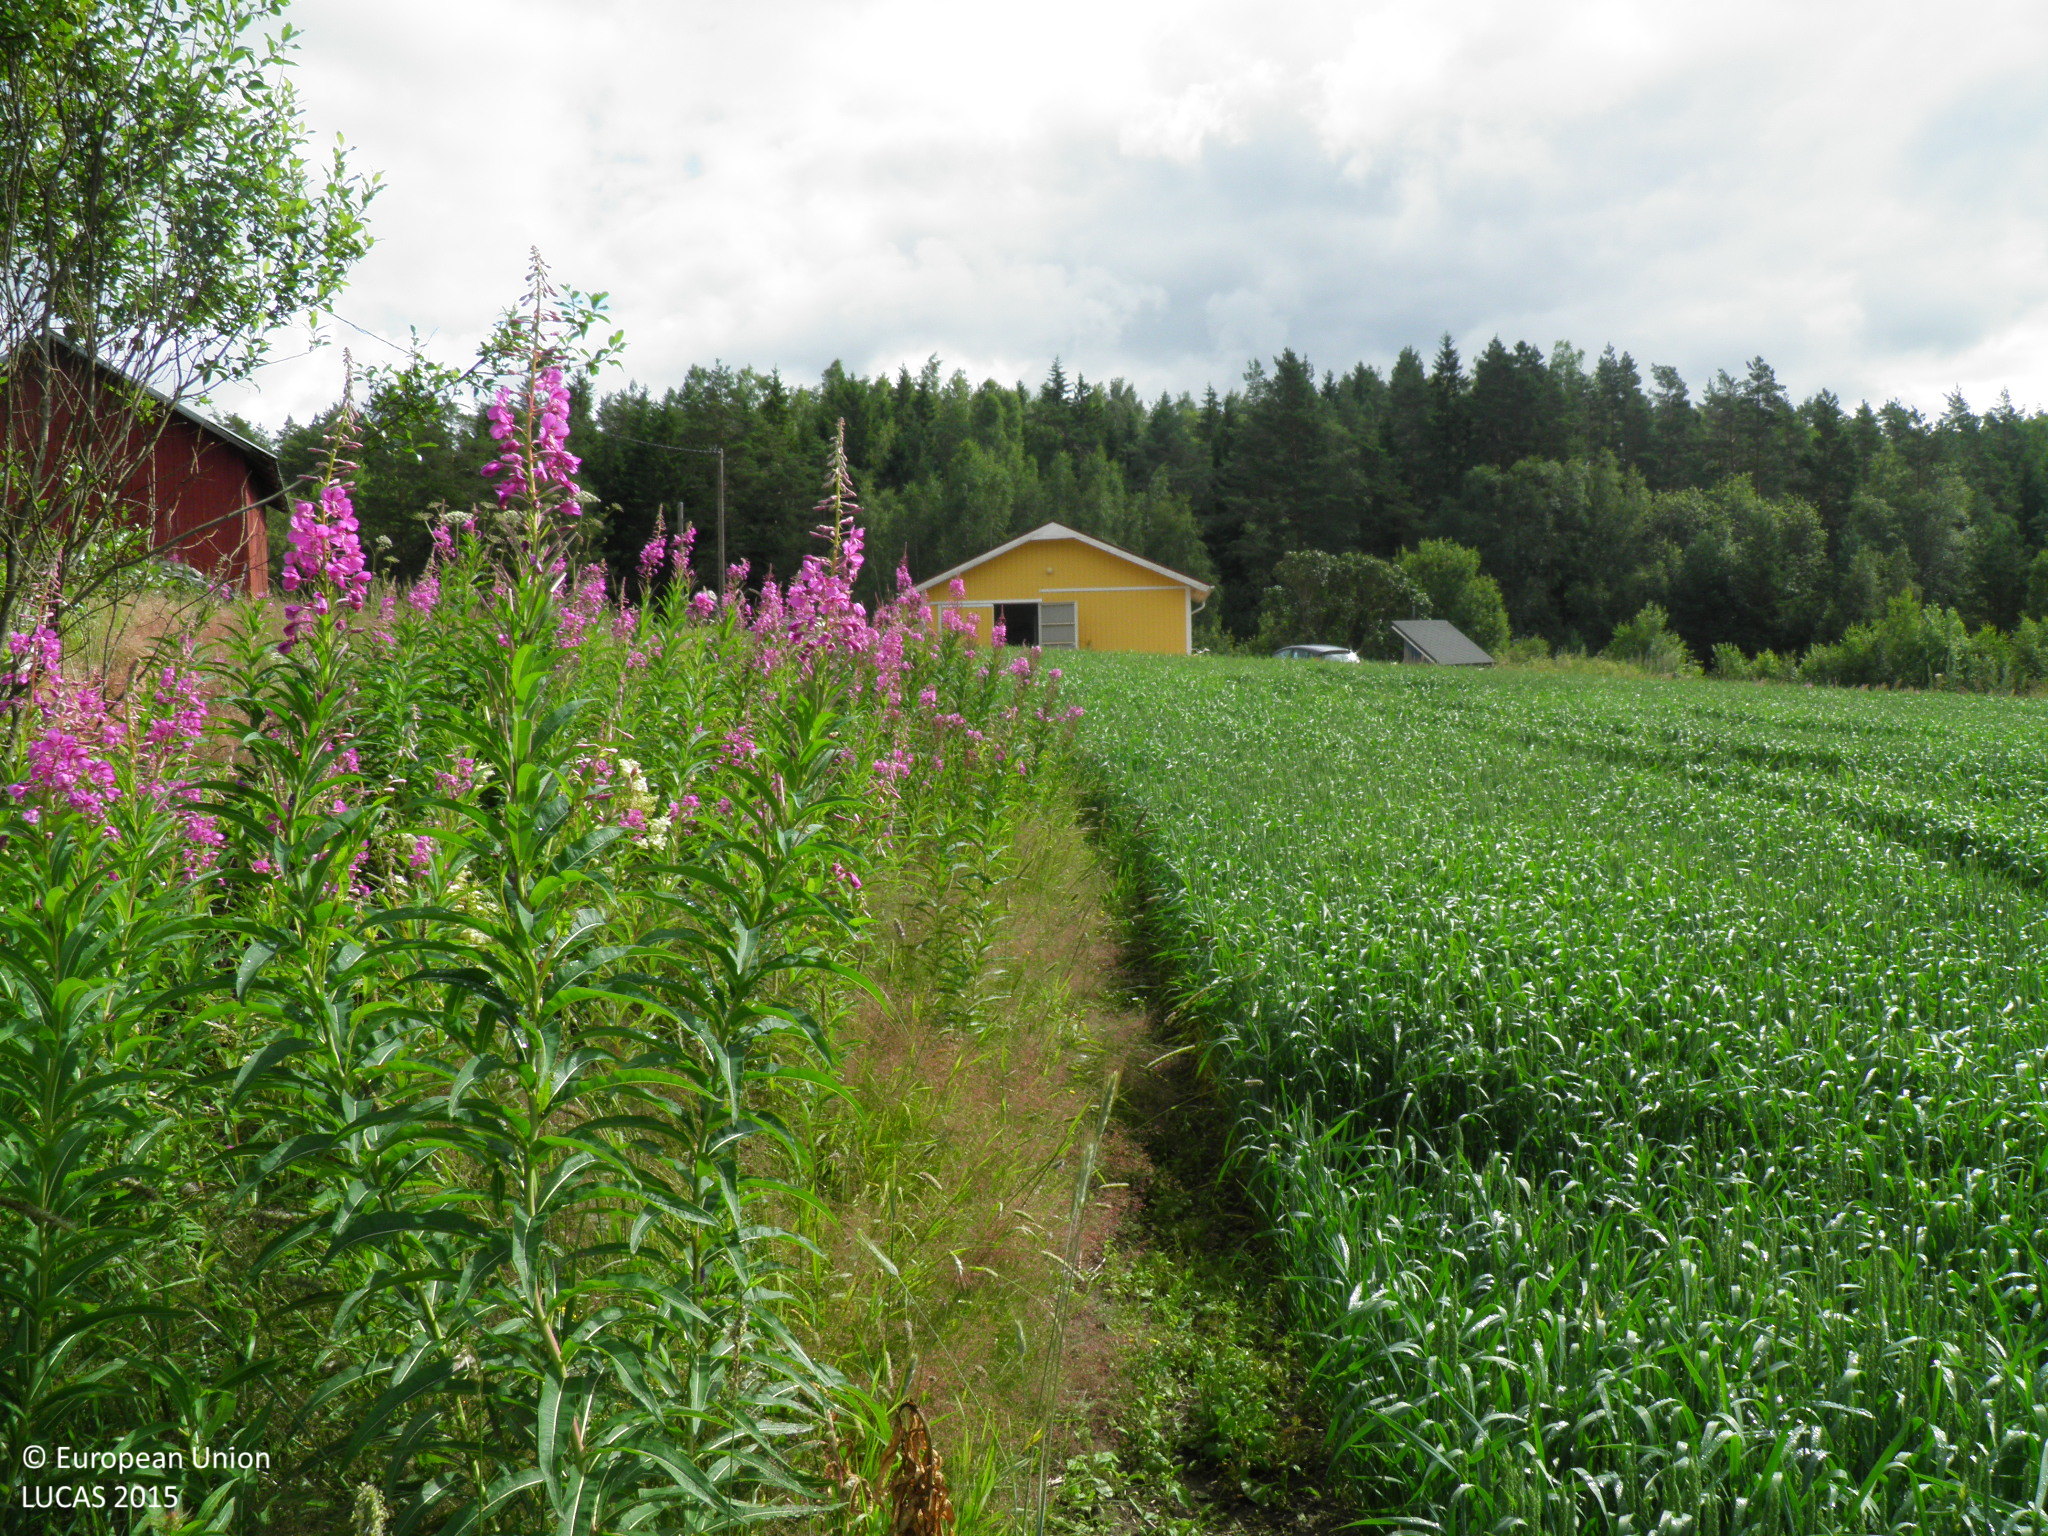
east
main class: Cropland
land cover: Common wheat
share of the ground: > 75 %
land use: Agriculture (excluding fallow land and kitchen gardens)
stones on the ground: < 10 %
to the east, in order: Common wheat; Pine dominated mixed woodland; Common wheat; Electric lines; Common wheat; Grass margins; Ditches and canals; Grassland without tree/shrub cover; Electric lines; Paved roads, cycling and walking lanes; Grass margins; Ditches and canals; Grass margins; Common wheat; Ditches and canals; Pine dominated coniferous woodland
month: July
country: FI
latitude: 60.1547
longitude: 22.6670
